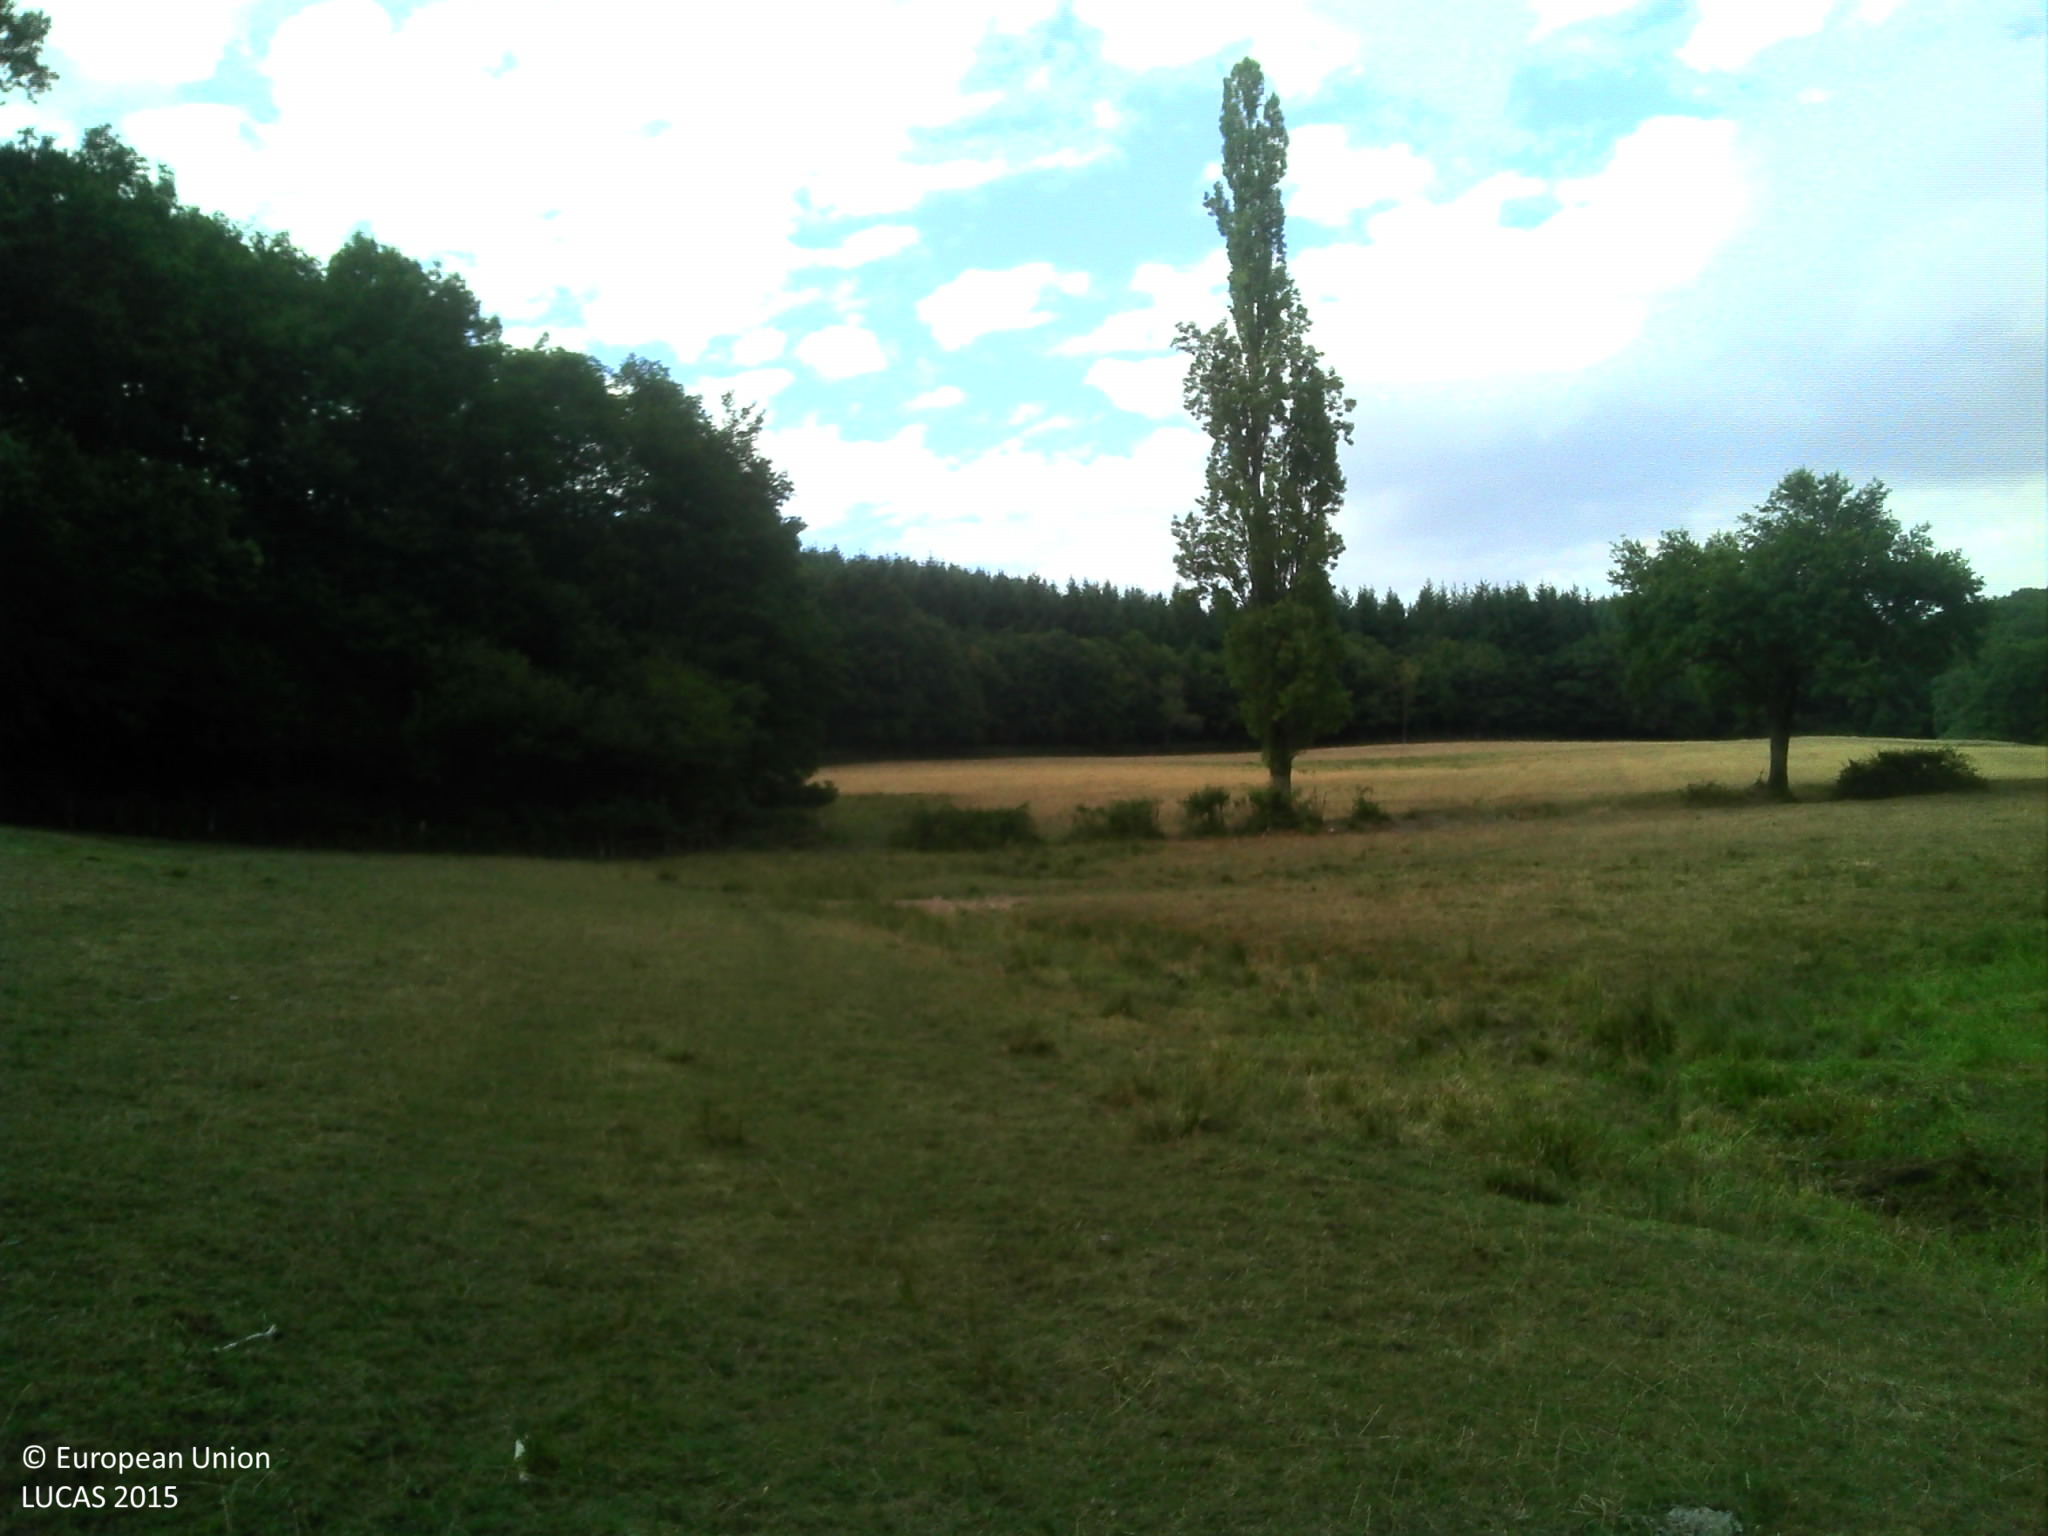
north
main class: Grassland
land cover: Grassland without tree/shrub cover
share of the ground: > 75 %
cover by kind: herbaceous plants 100 %
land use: Agriculture (excluding fallow land and kitchen gardens)
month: August
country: FR
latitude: 46.6582
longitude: 4.4469
